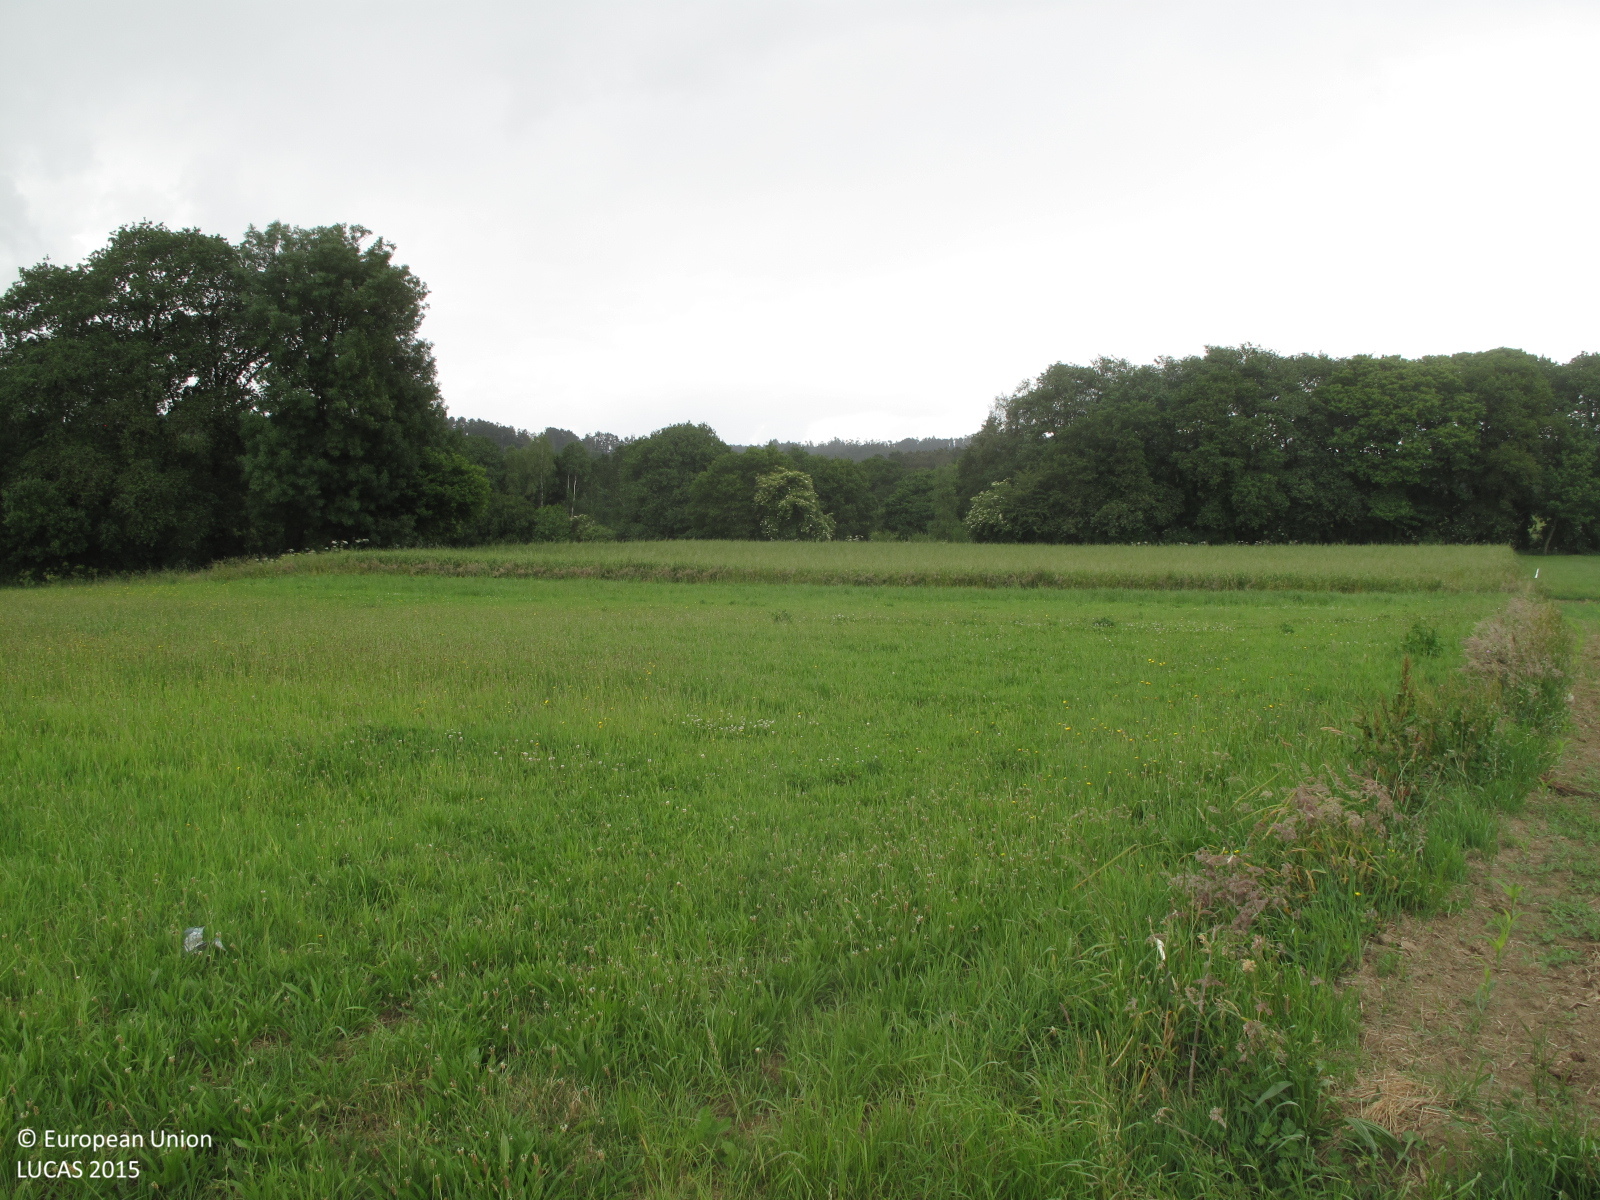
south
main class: Cropland
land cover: Maize
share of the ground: < 10 %
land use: Agriculture (excluding fallow land and kitchen gardens)
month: June
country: ES
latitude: 43.0725
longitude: -8.5160
